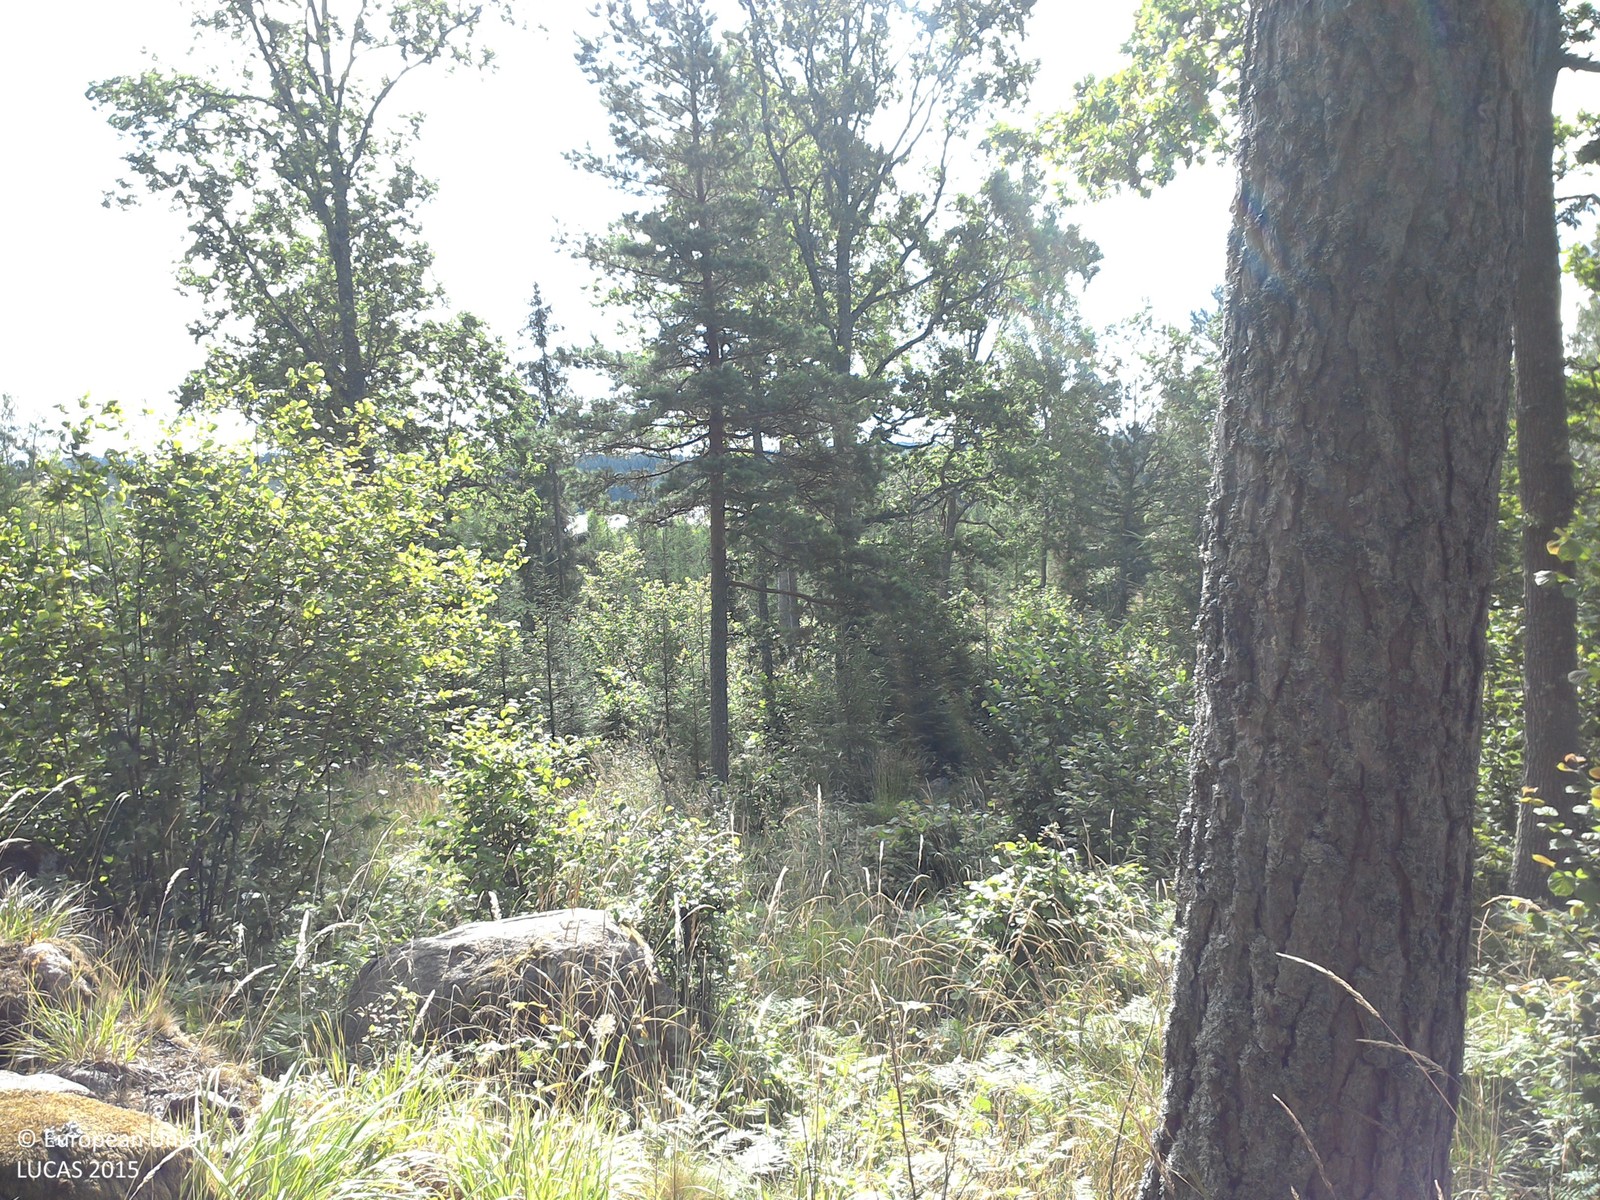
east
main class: Woodland
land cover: Pine dominated coniferous woodland
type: boreal forest
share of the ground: 50 - 75 %
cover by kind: coniferous forest trees 55 %, herbaceous plants 25 %, lichens and mosses 20 %
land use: Forestry
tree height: > 5 m
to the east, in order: Pine dominated coniferous woodland; Pine dominated mixed woodland; Spruce dominated coniferous woodland; Spruce dominated mixed woodland; Paved roads, cycling and walking lanes; Broadleaved woodland; Inland fresh water bodies
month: July
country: SE
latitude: 57.8848
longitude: 16.0515
